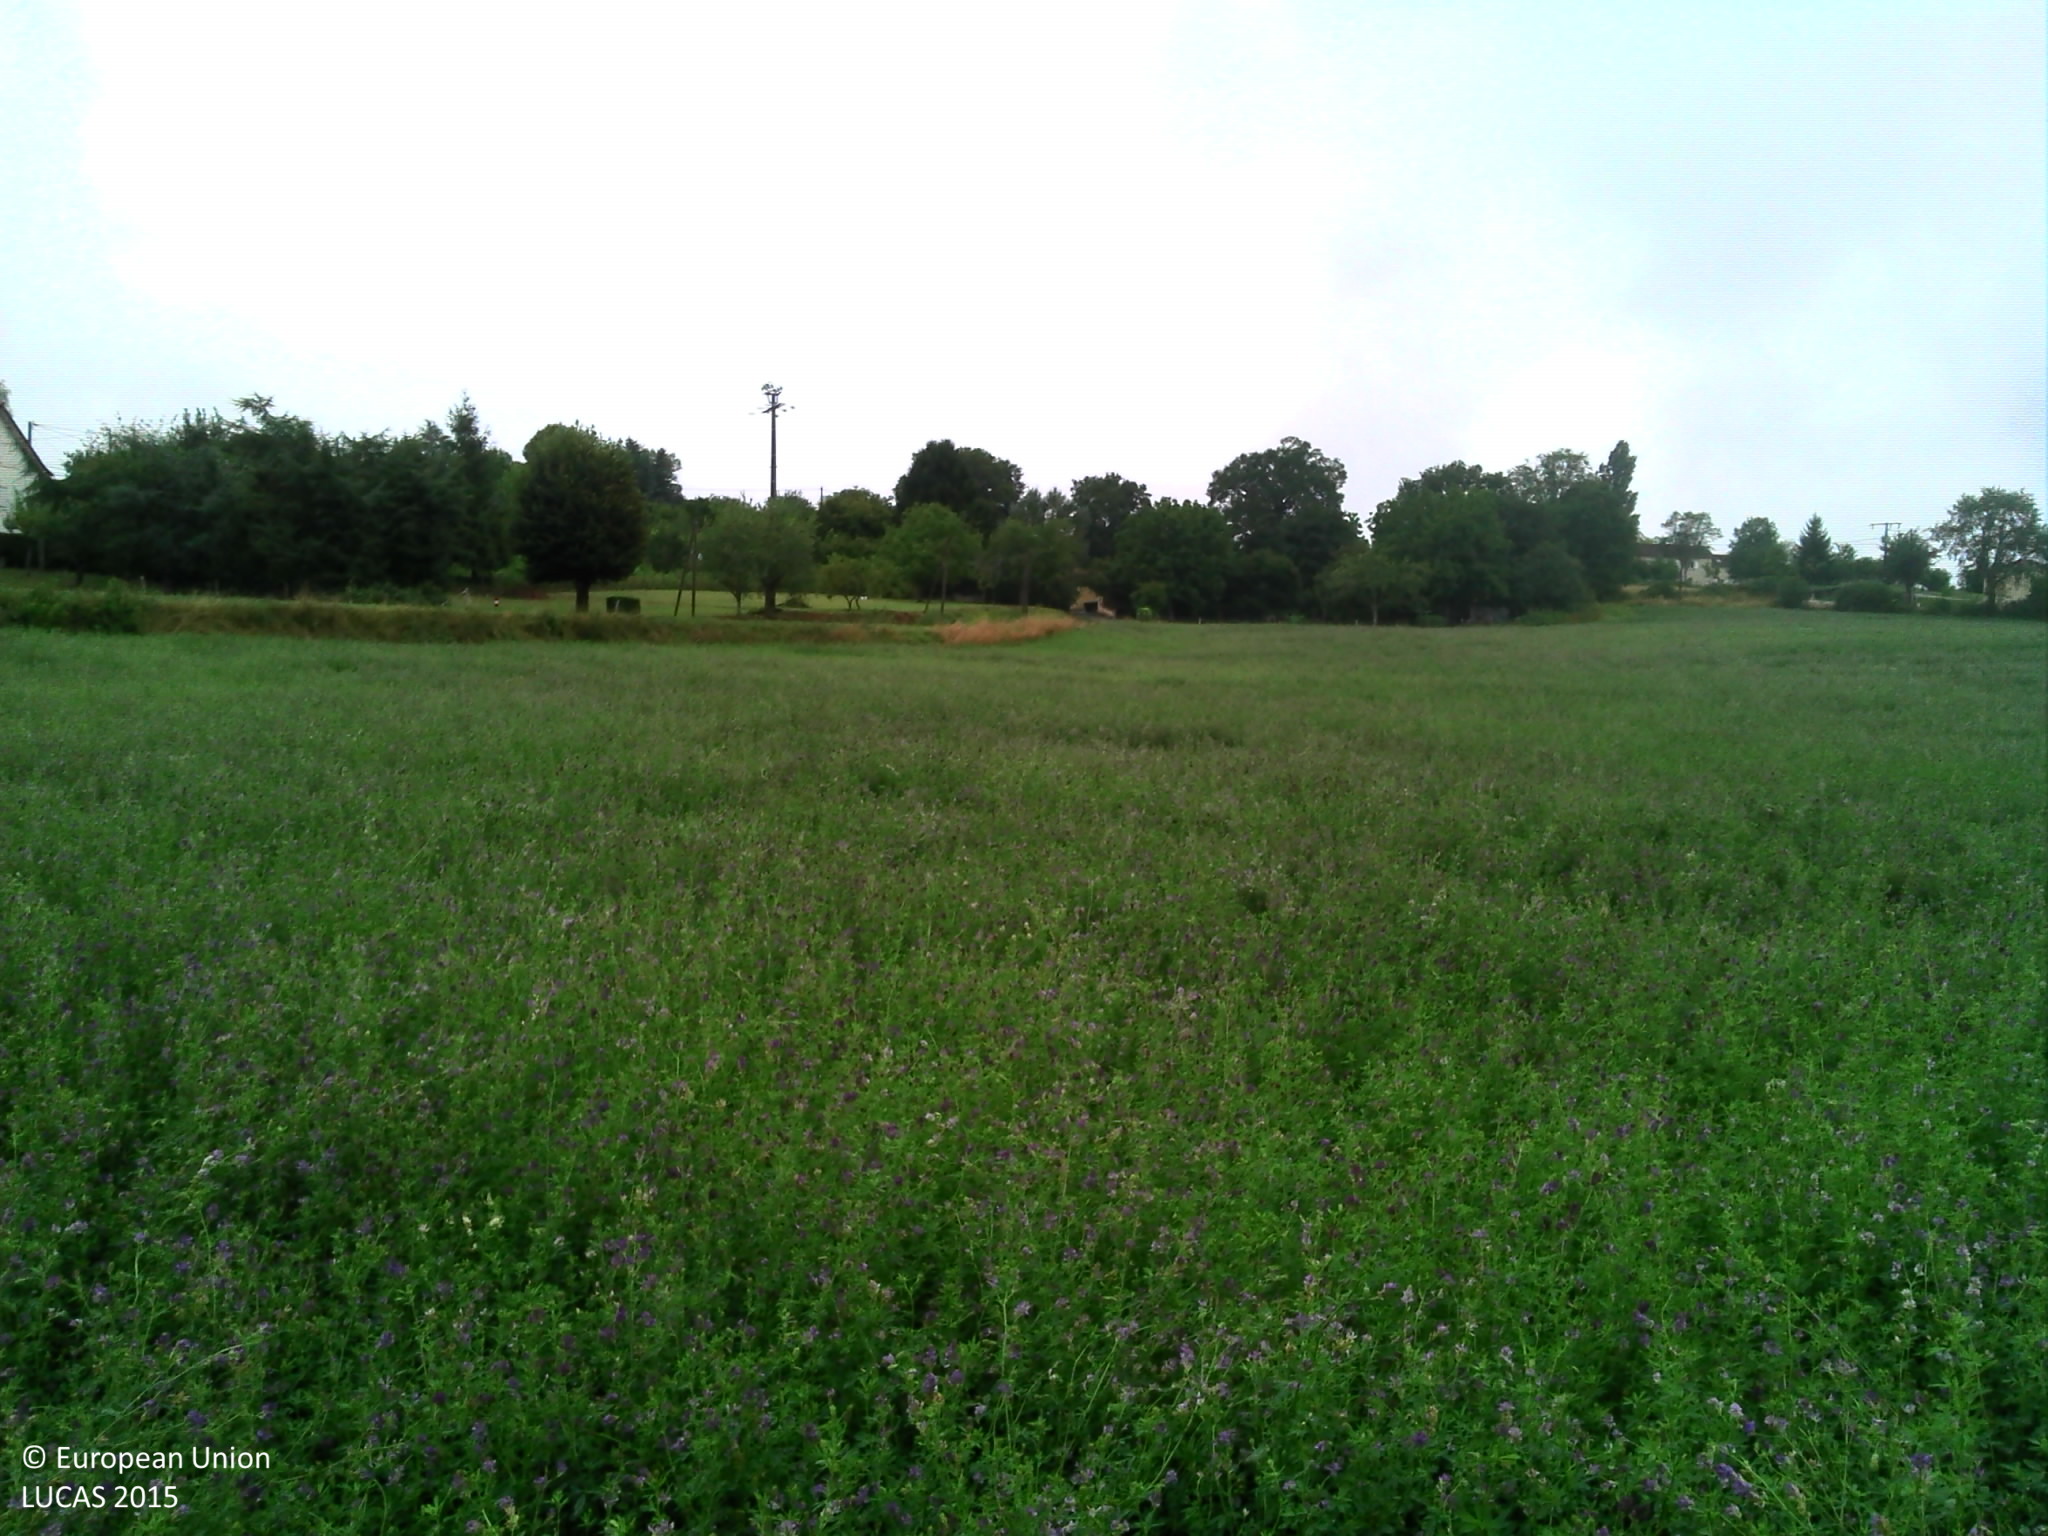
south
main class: Cropland
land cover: Lucerne
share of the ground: > 75 %
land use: Agriculture (excluding fallow land and kitchen gardens)
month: August
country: FR
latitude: 45.5064
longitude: 0.6576
